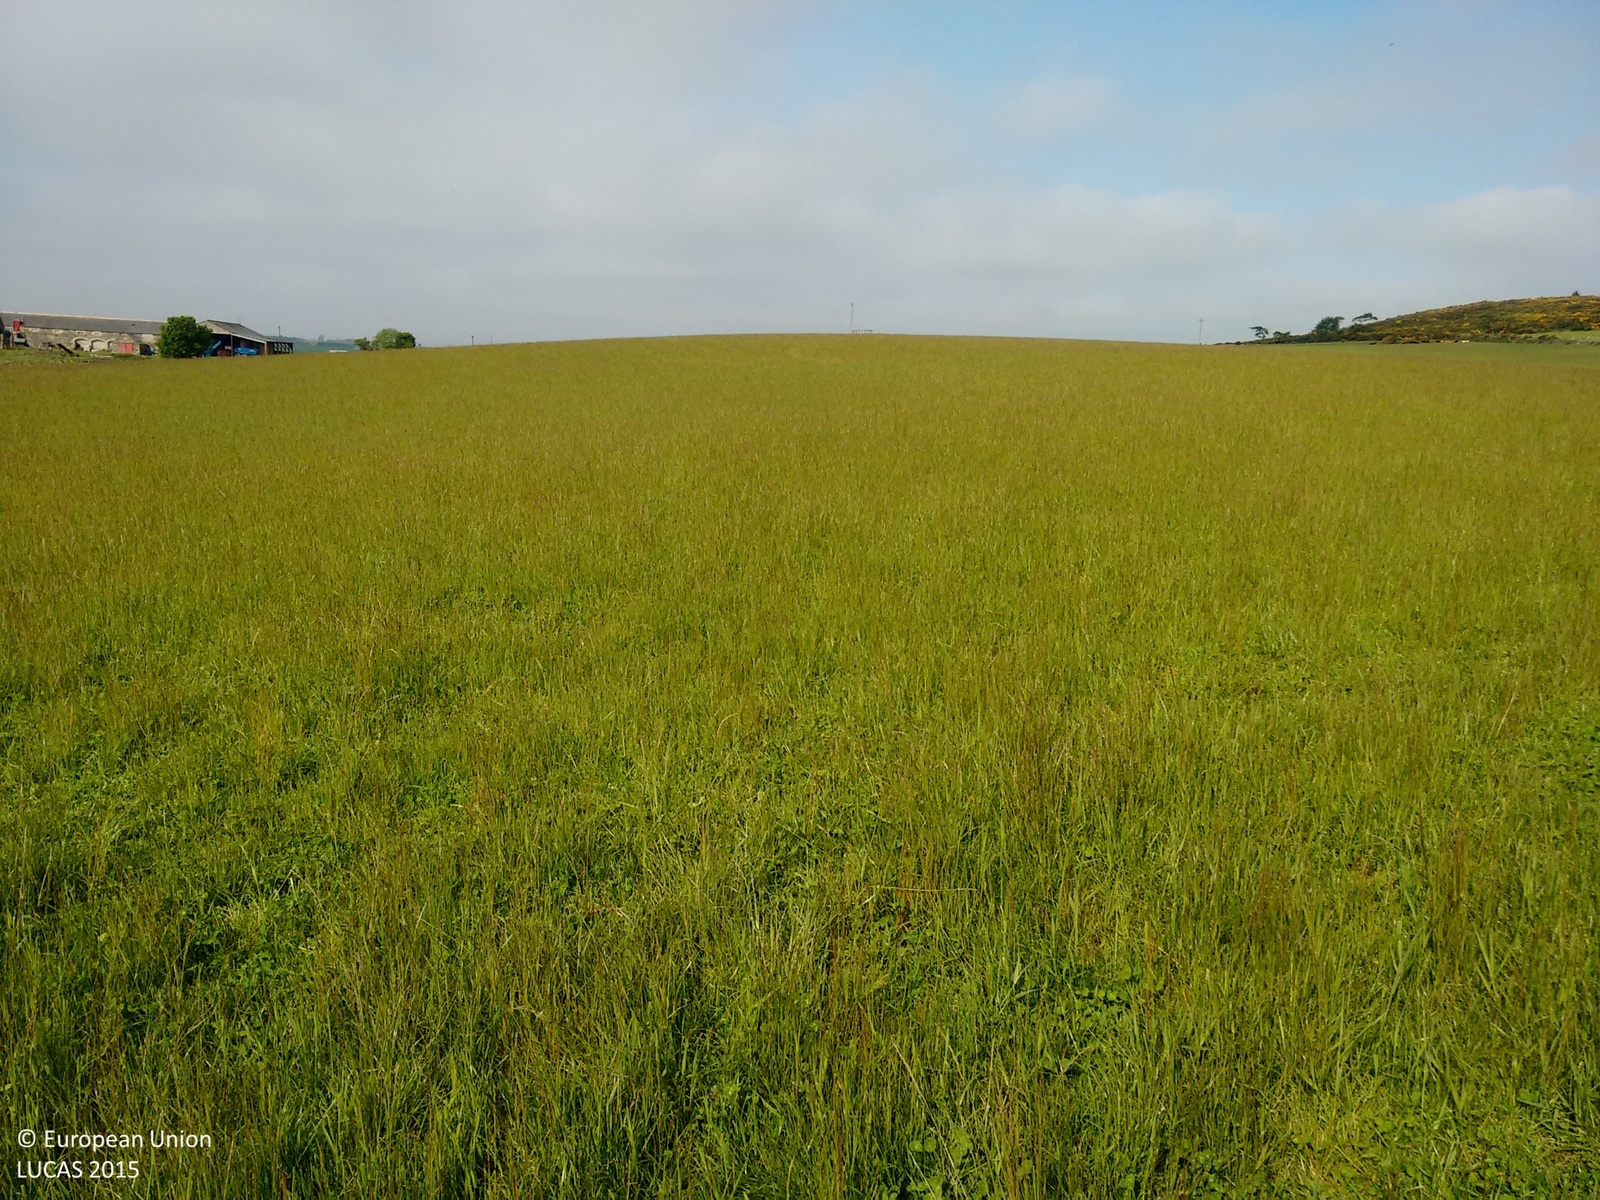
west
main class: Grassland
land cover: Grassland without tree/shrub cover
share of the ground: > 75 %
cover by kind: herbaceous plants 100 %
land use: Agriculture (excluding fallow land and kitchen gardens)
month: June
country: GB
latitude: 57.2516
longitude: -2.0975
